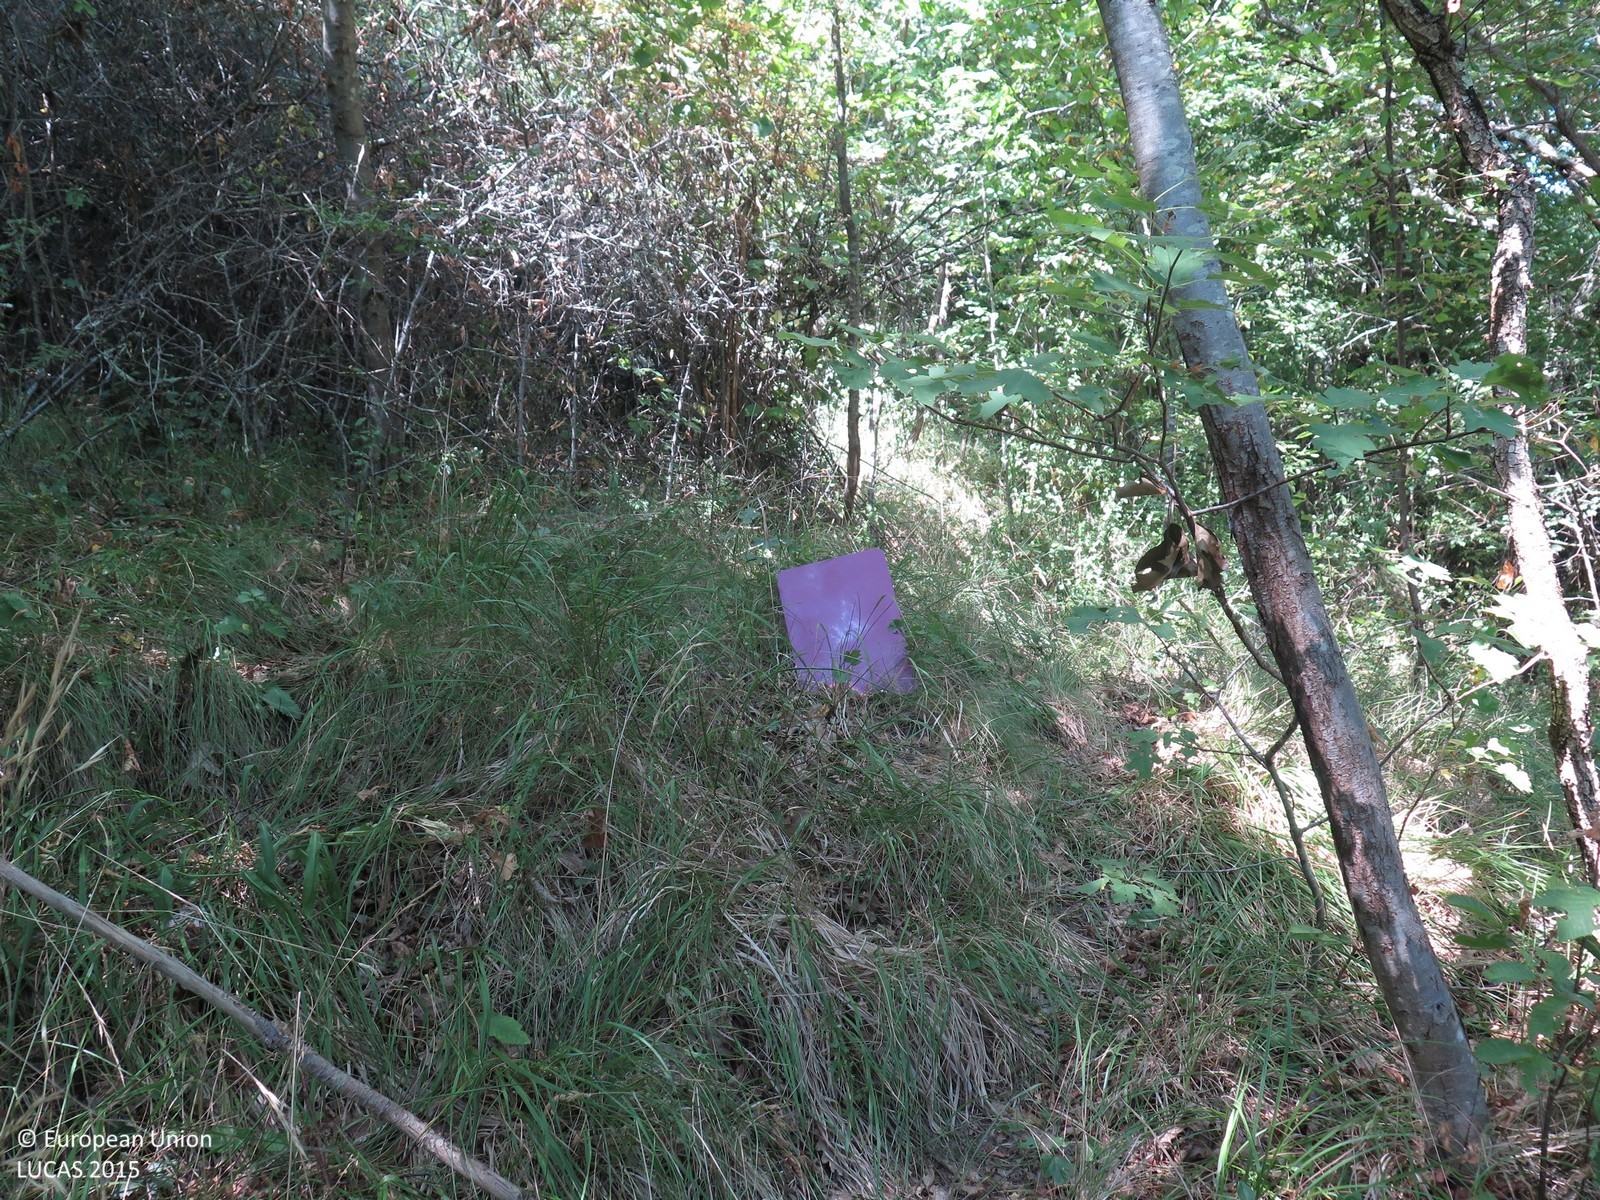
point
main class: Woodland
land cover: Broadleaved woodland
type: acidophilous oak and oak-birch forest
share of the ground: > 75 %
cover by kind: broadleaved forest trees 90 %, coniferous forest trees 5 %, herbaceous plants 5 %
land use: Semi-natural and natural areas not in use
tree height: > 5 m
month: July
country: HR
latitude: 45.4372
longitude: 13.7663
